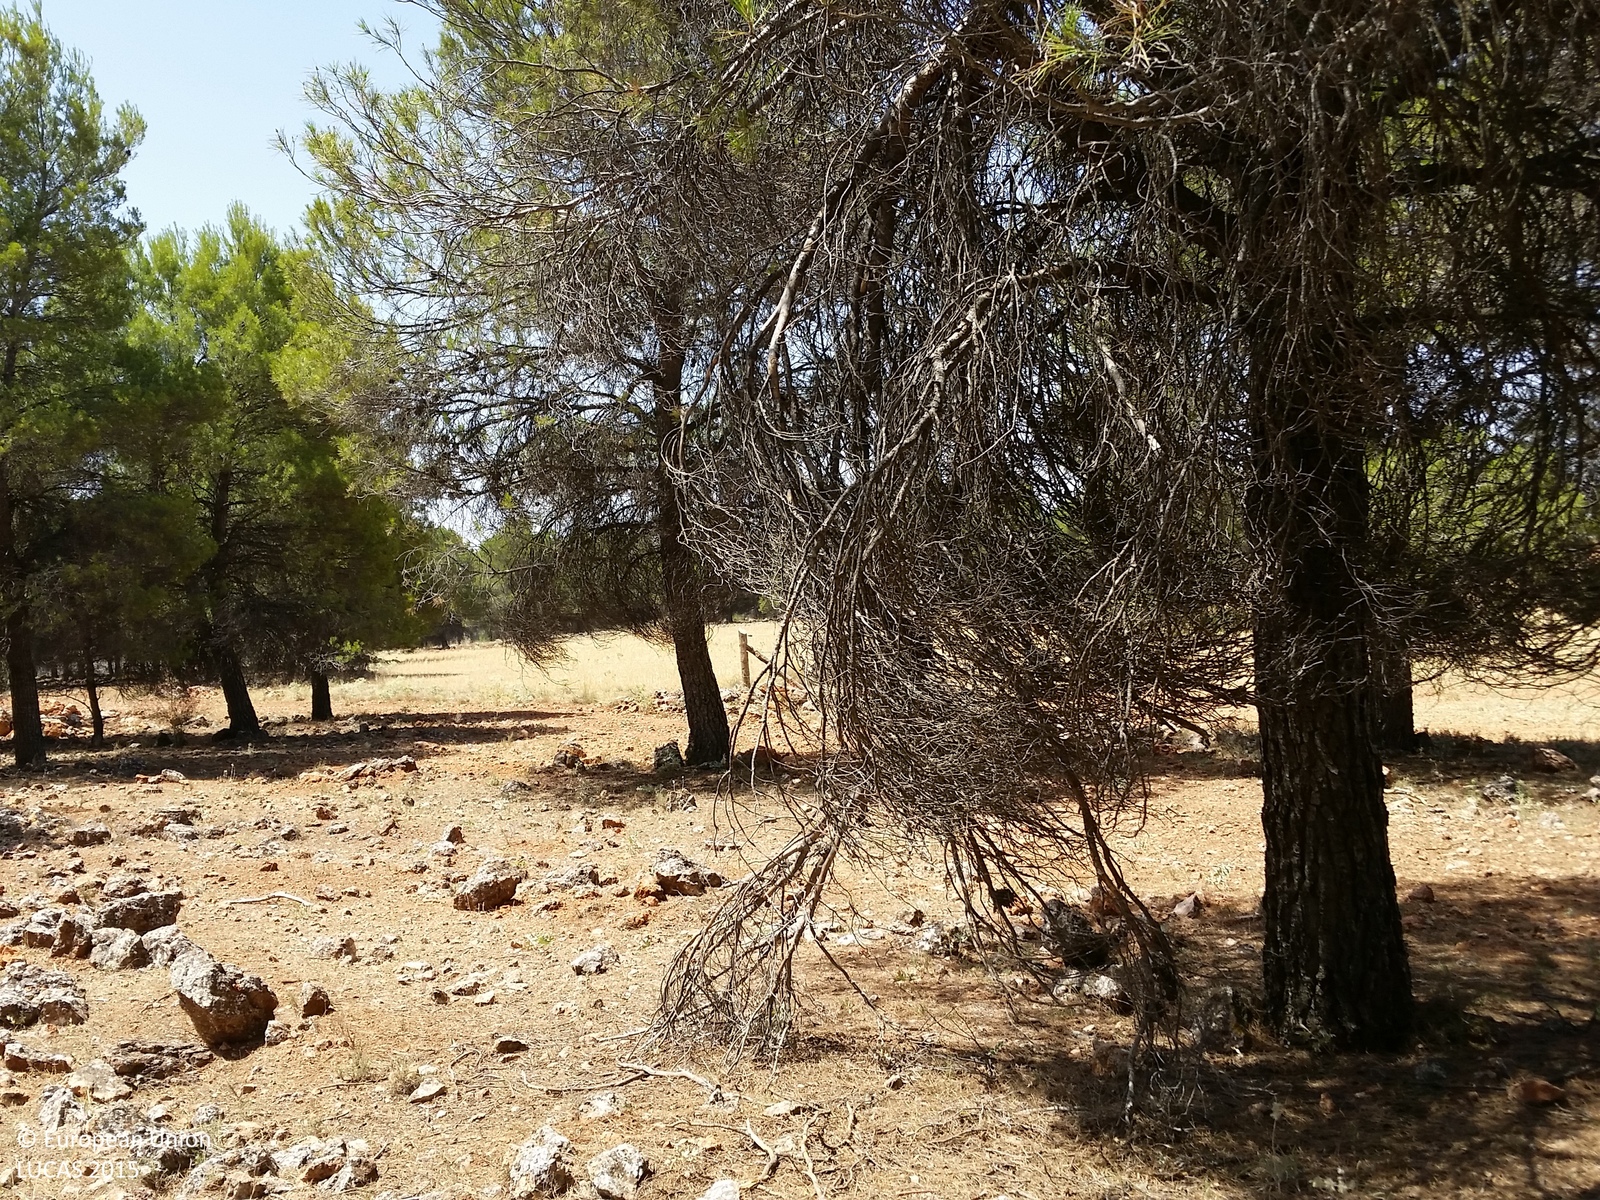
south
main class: Woodland
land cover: Pine dominated coniferous woodland
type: coniferous forest of the mediterranean region
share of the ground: > 75 %
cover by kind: coniferous forest trees 70 %, shrubs 20 %, consolidated bare surface 10 %
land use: Semi-natural and natural areas not in use
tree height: > 5 m
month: July
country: ES
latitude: 38.9193
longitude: -2.6118
